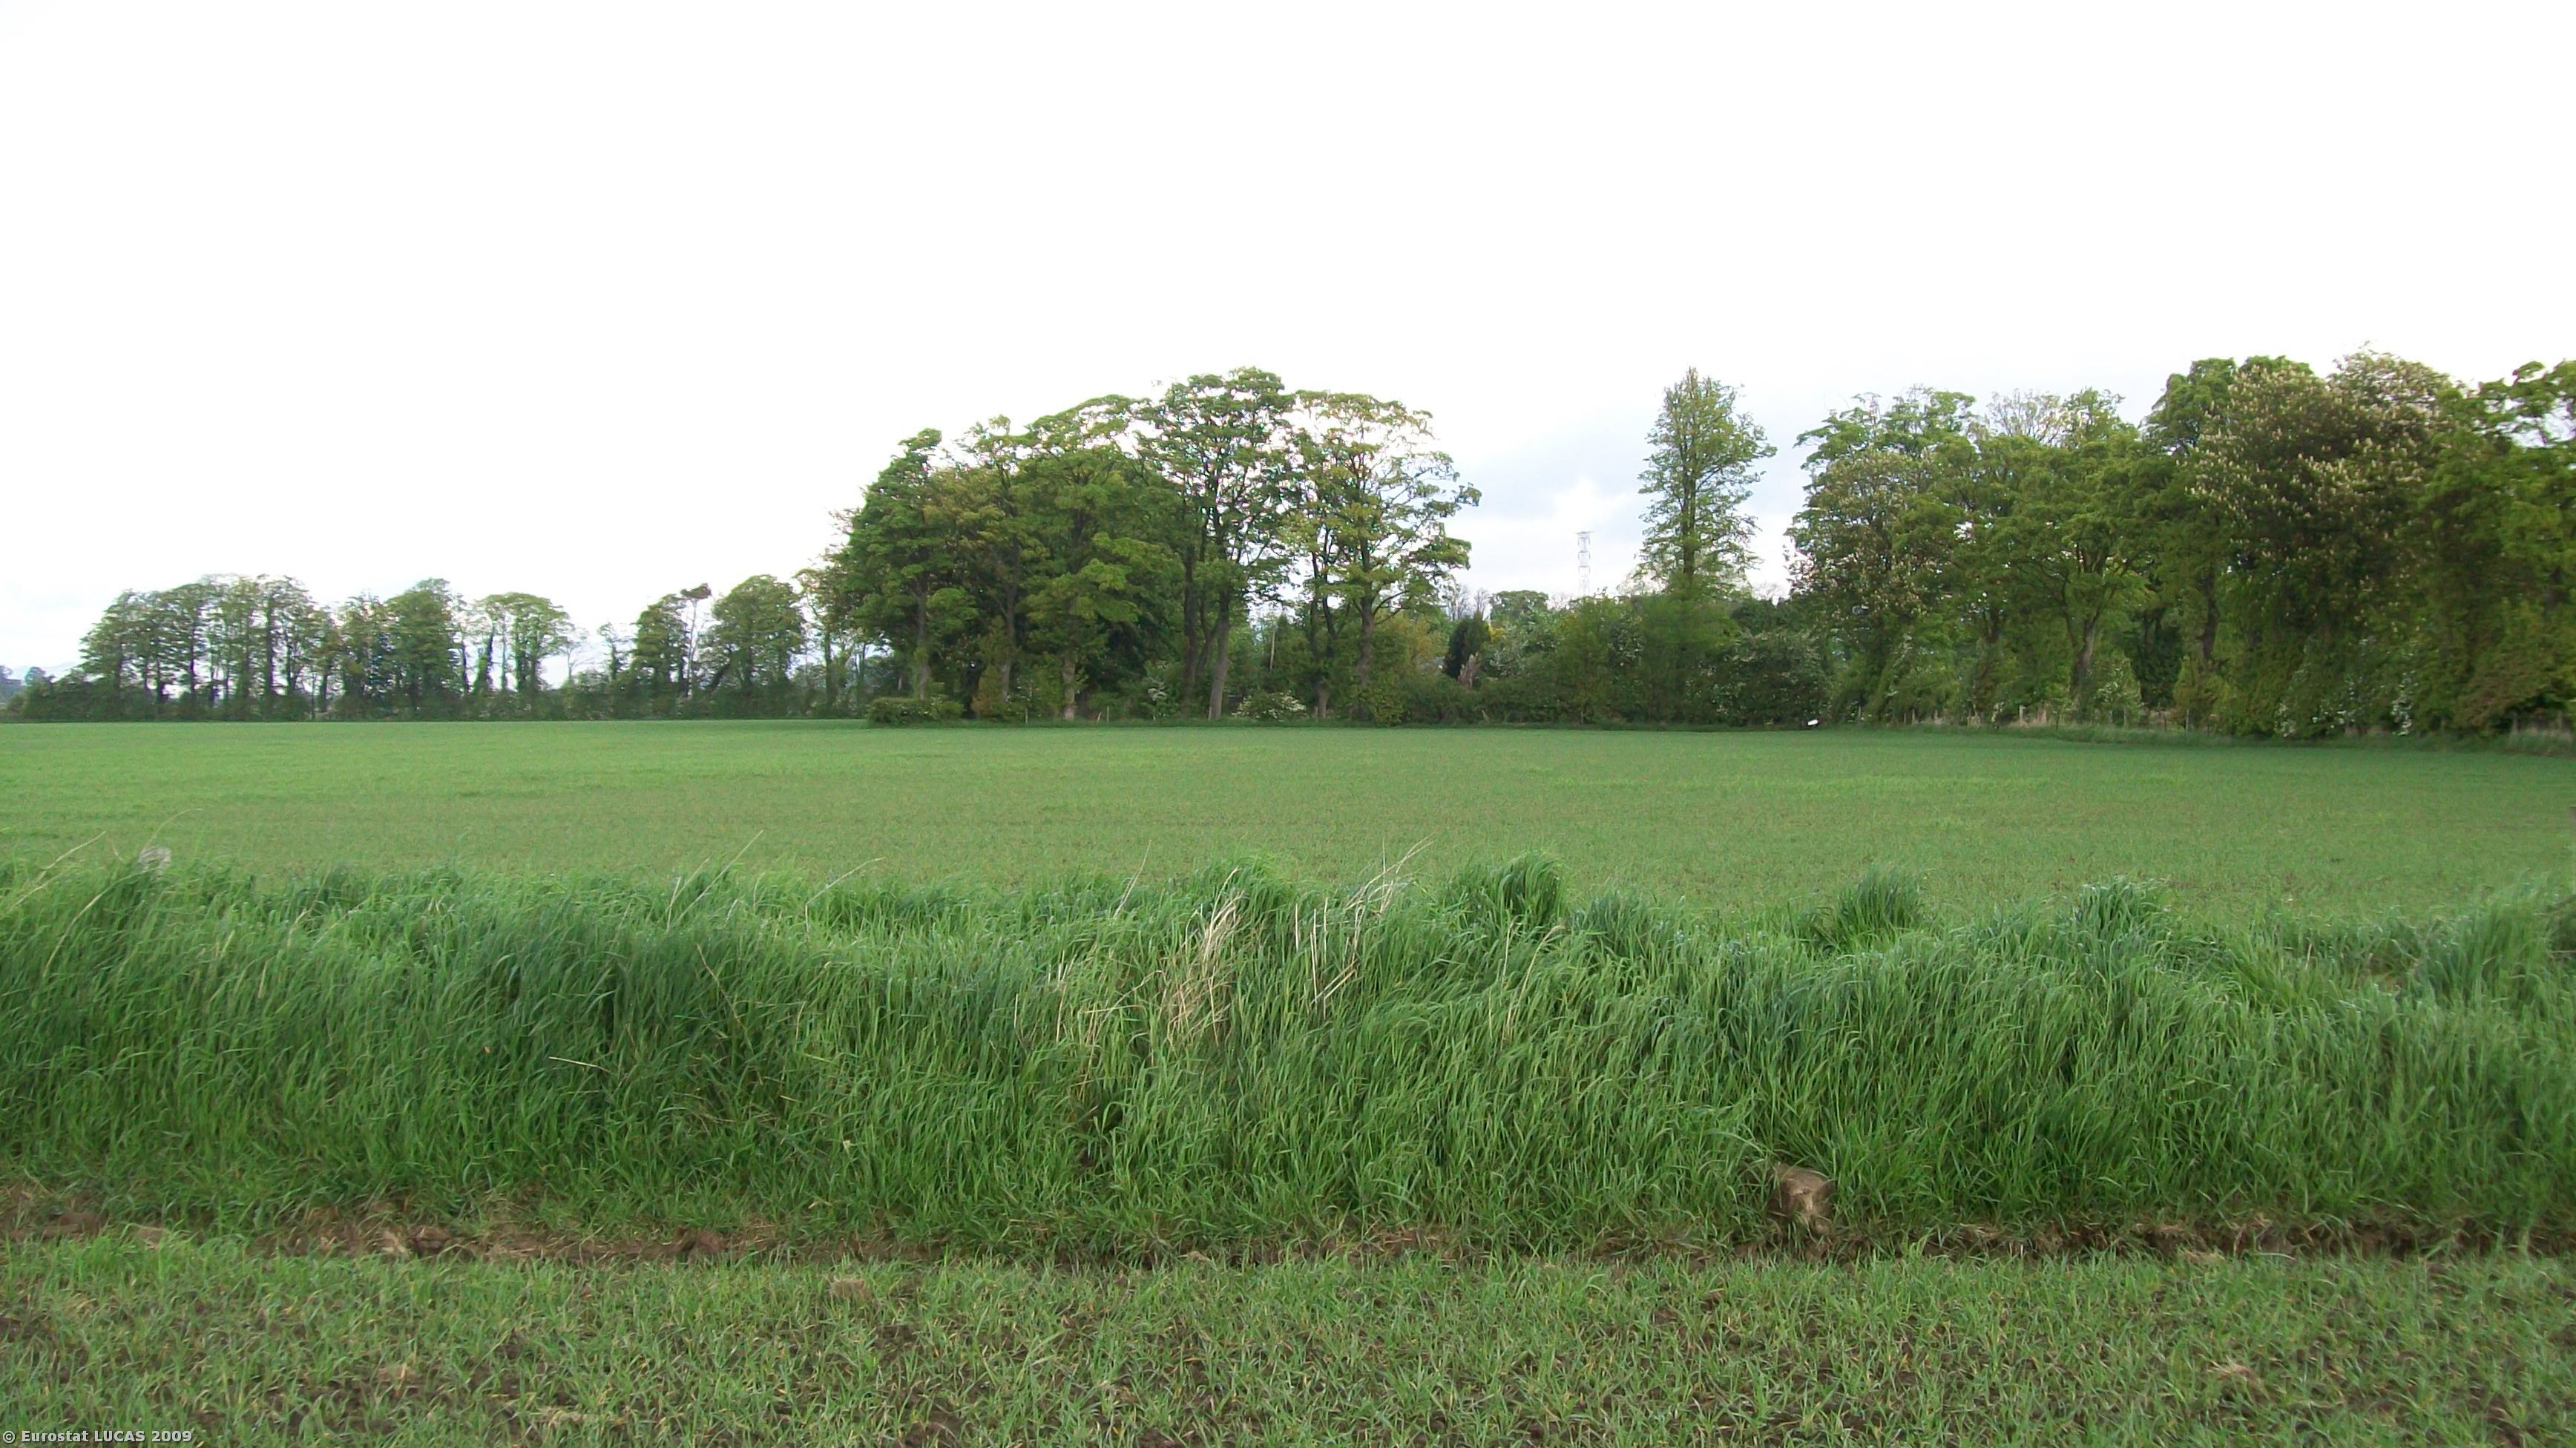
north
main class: Cropland
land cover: Barley
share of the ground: > 75 %
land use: Agriculture (excluding fallow land and kitchen gardens)
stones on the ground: < 10 %
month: May
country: GB
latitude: 56.0463
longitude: -3.7437
